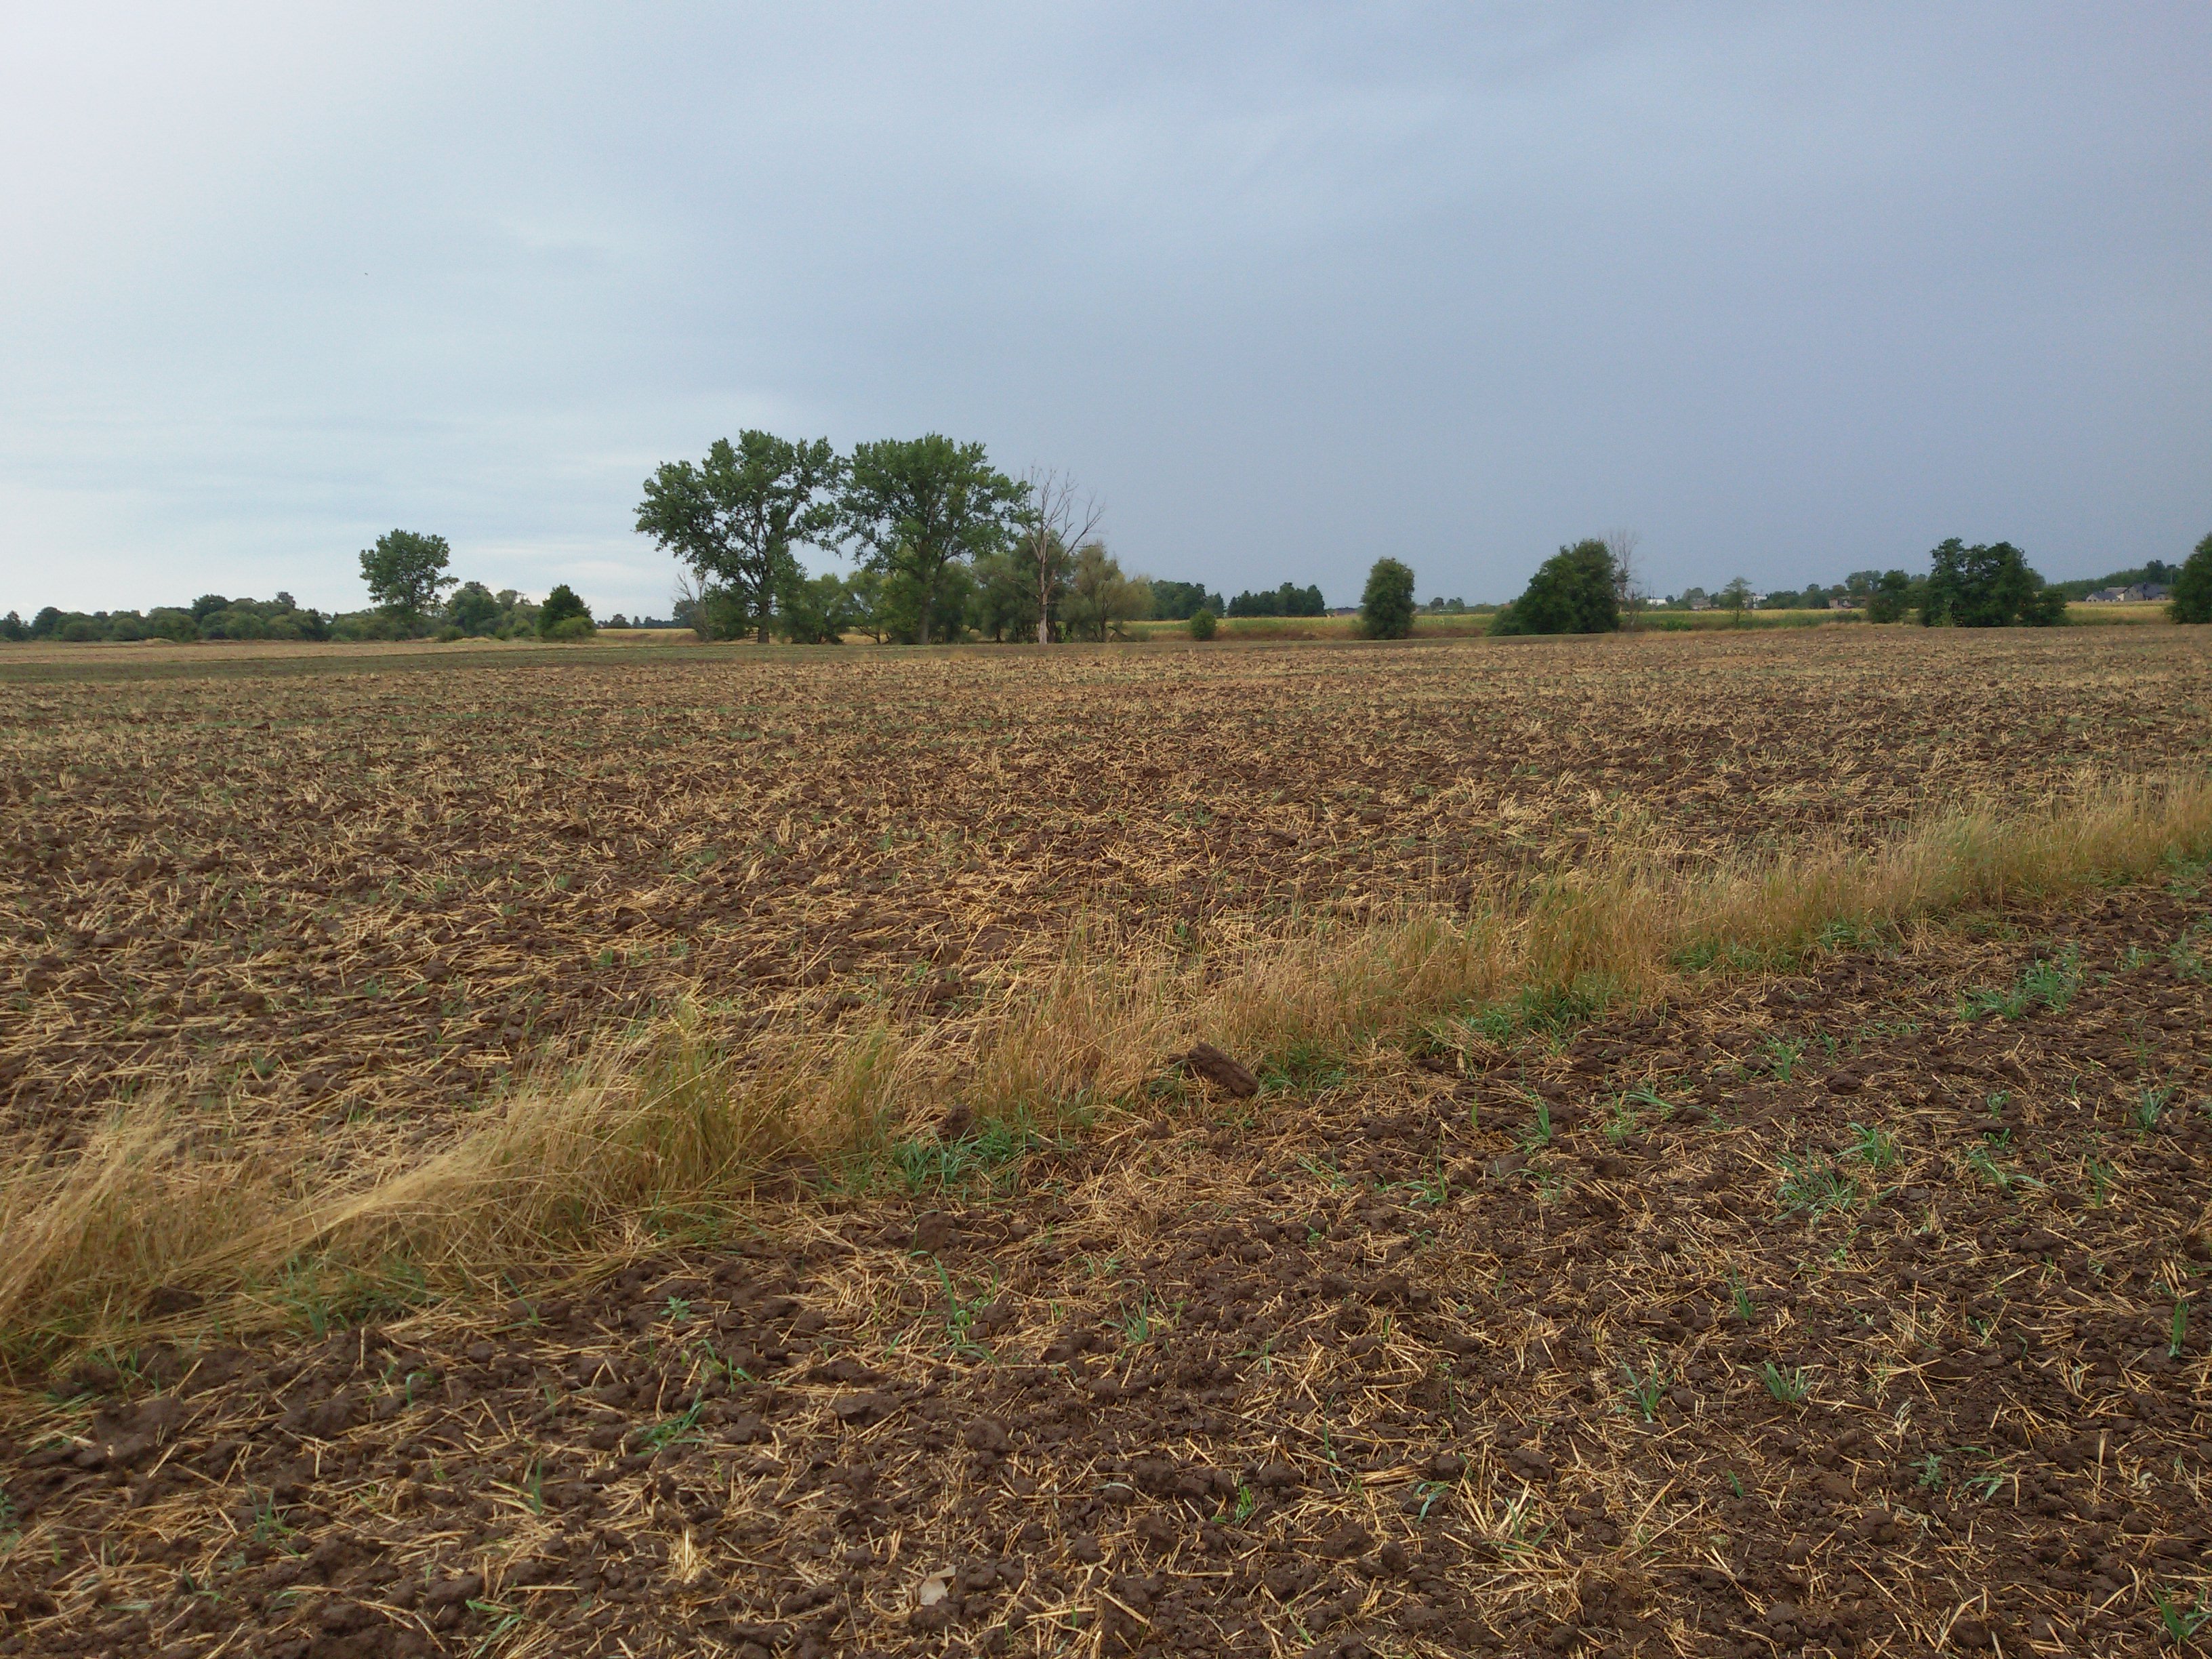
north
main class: Cropland
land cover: Rye
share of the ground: 25 - 50 %
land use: Agriculture (excluding fallow land and kitchen gardens)
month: August
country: PL
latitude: 51.9325
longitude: 17.9125
